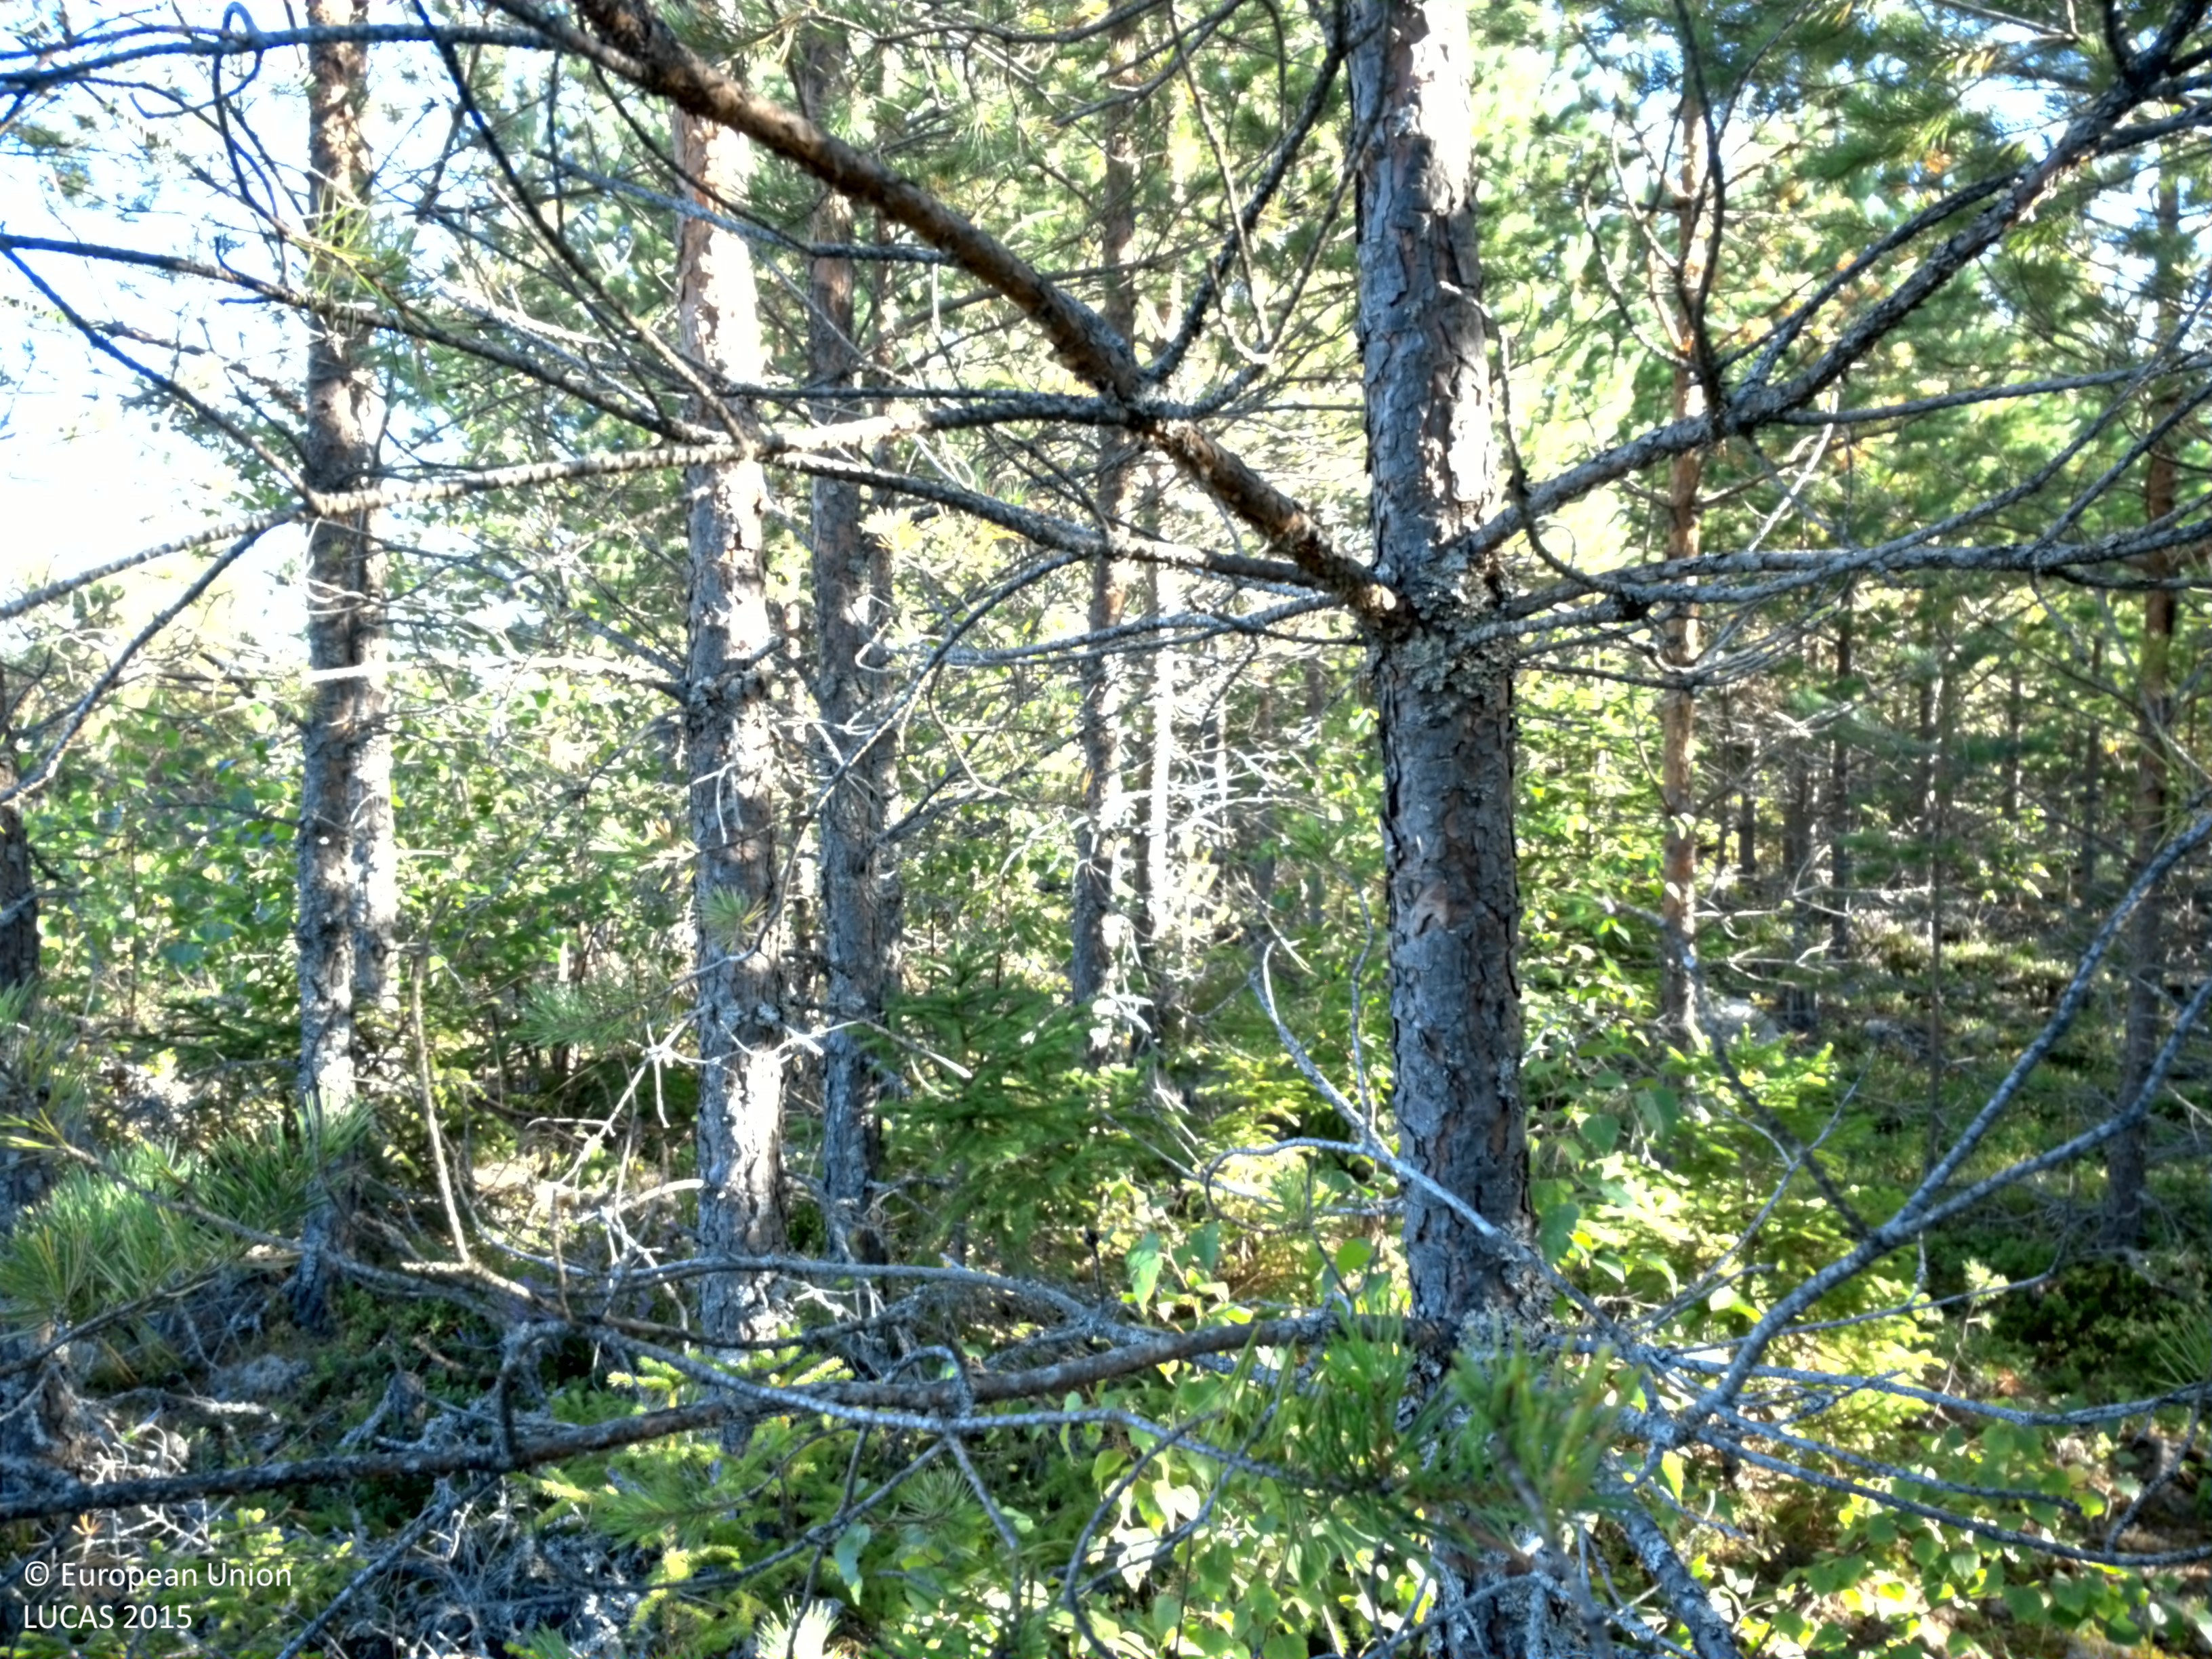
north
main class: Woodland
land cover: Pine dominated coniferous woodland
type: boreal forest
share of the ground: > 75 %
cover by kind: coniferous forest trees 65 %, shrubs 20 %, broadleaved forest trees 10 %, lichens and mosses 5 %
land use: Forestry
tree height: > 5 m
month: August
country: SE
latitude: 60.0907
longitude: 17.1295
